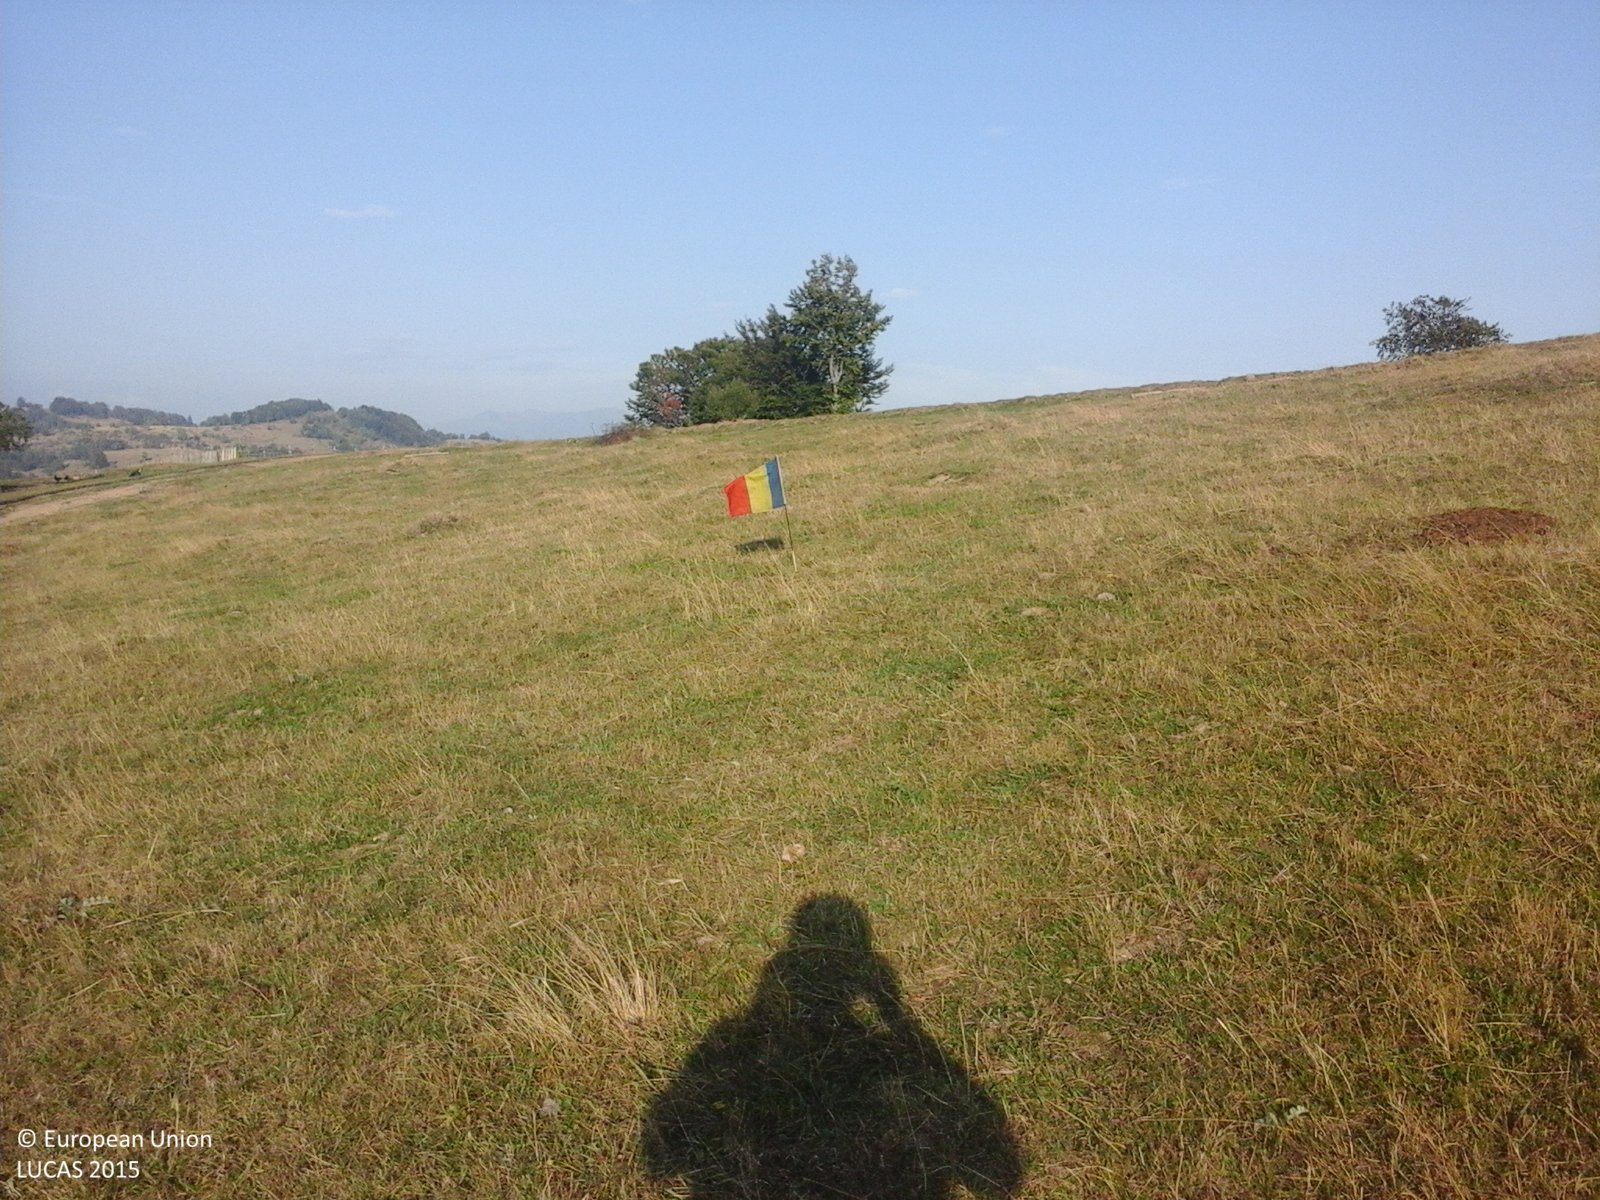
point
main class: Grassland
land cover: Grassland without tree/shrub cover
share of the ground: > 75 %
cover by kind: herbaceous plants 100 %
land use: Agriculture (excluding fallow land and kitchen gardens)
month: September
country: RO
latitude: 45.1596
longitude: 22.1876
